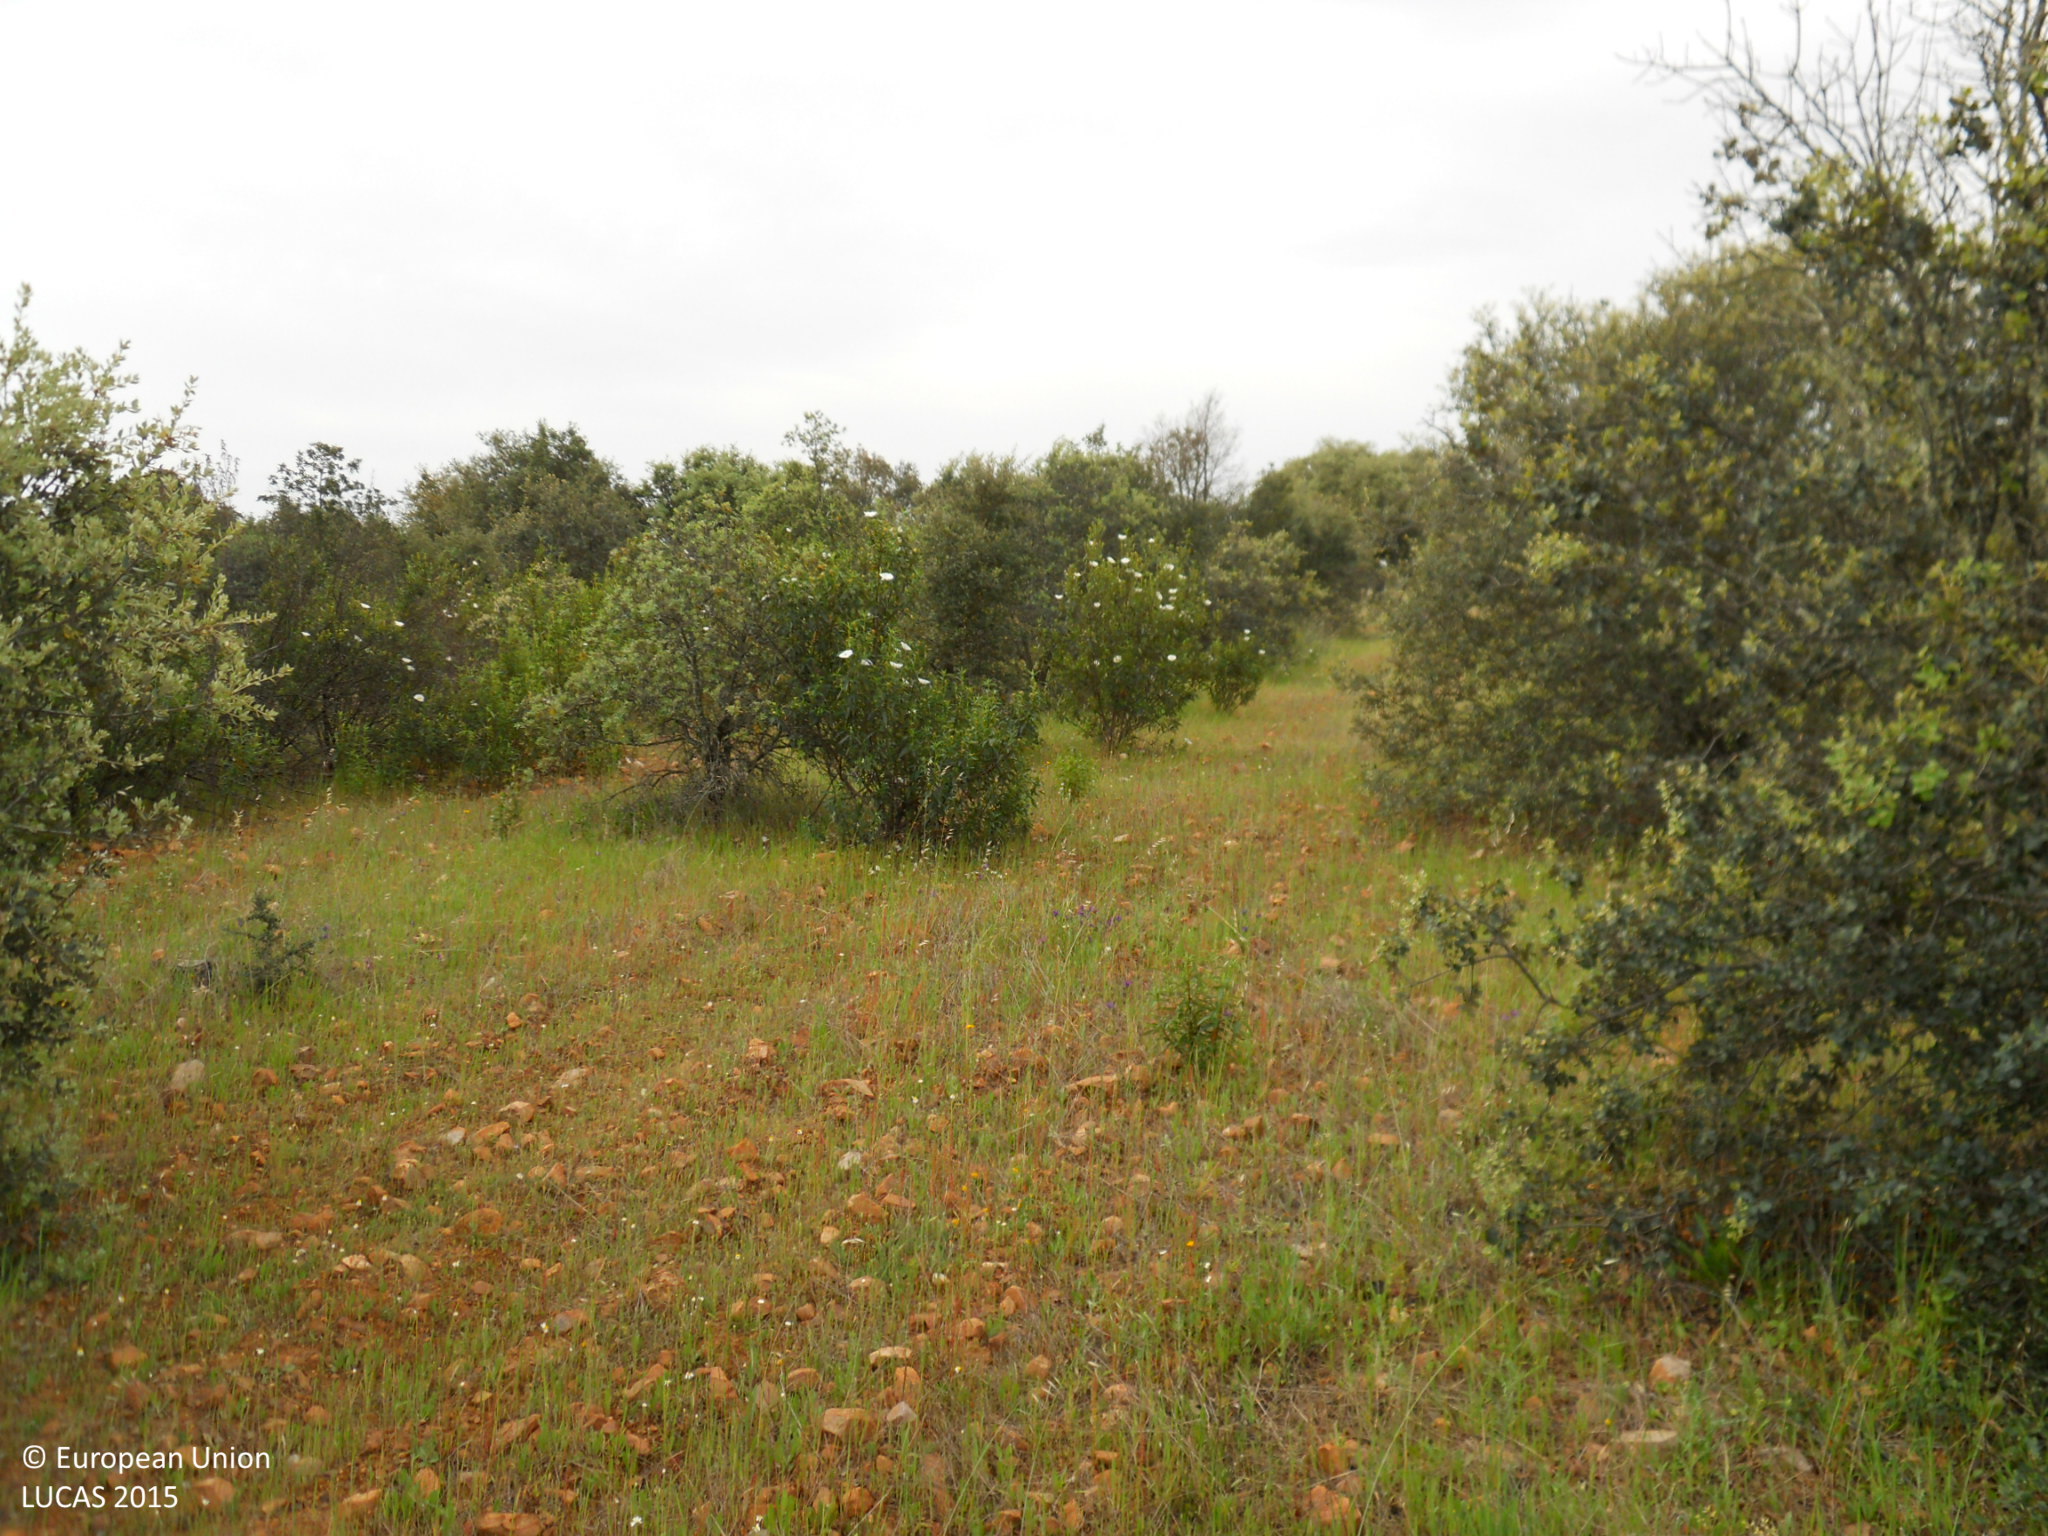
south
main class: Woodland
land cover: Broadleaved woodland
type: broadleaved evergreen forest
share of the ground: > 75 %
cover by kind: broadleaved forest trees 40 %, unconsolidated bare surface 40 %, shrubs 20 %
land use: Forestry
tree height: < 5 m
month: April
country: ES
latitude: 39.1096
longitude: -6.5446
